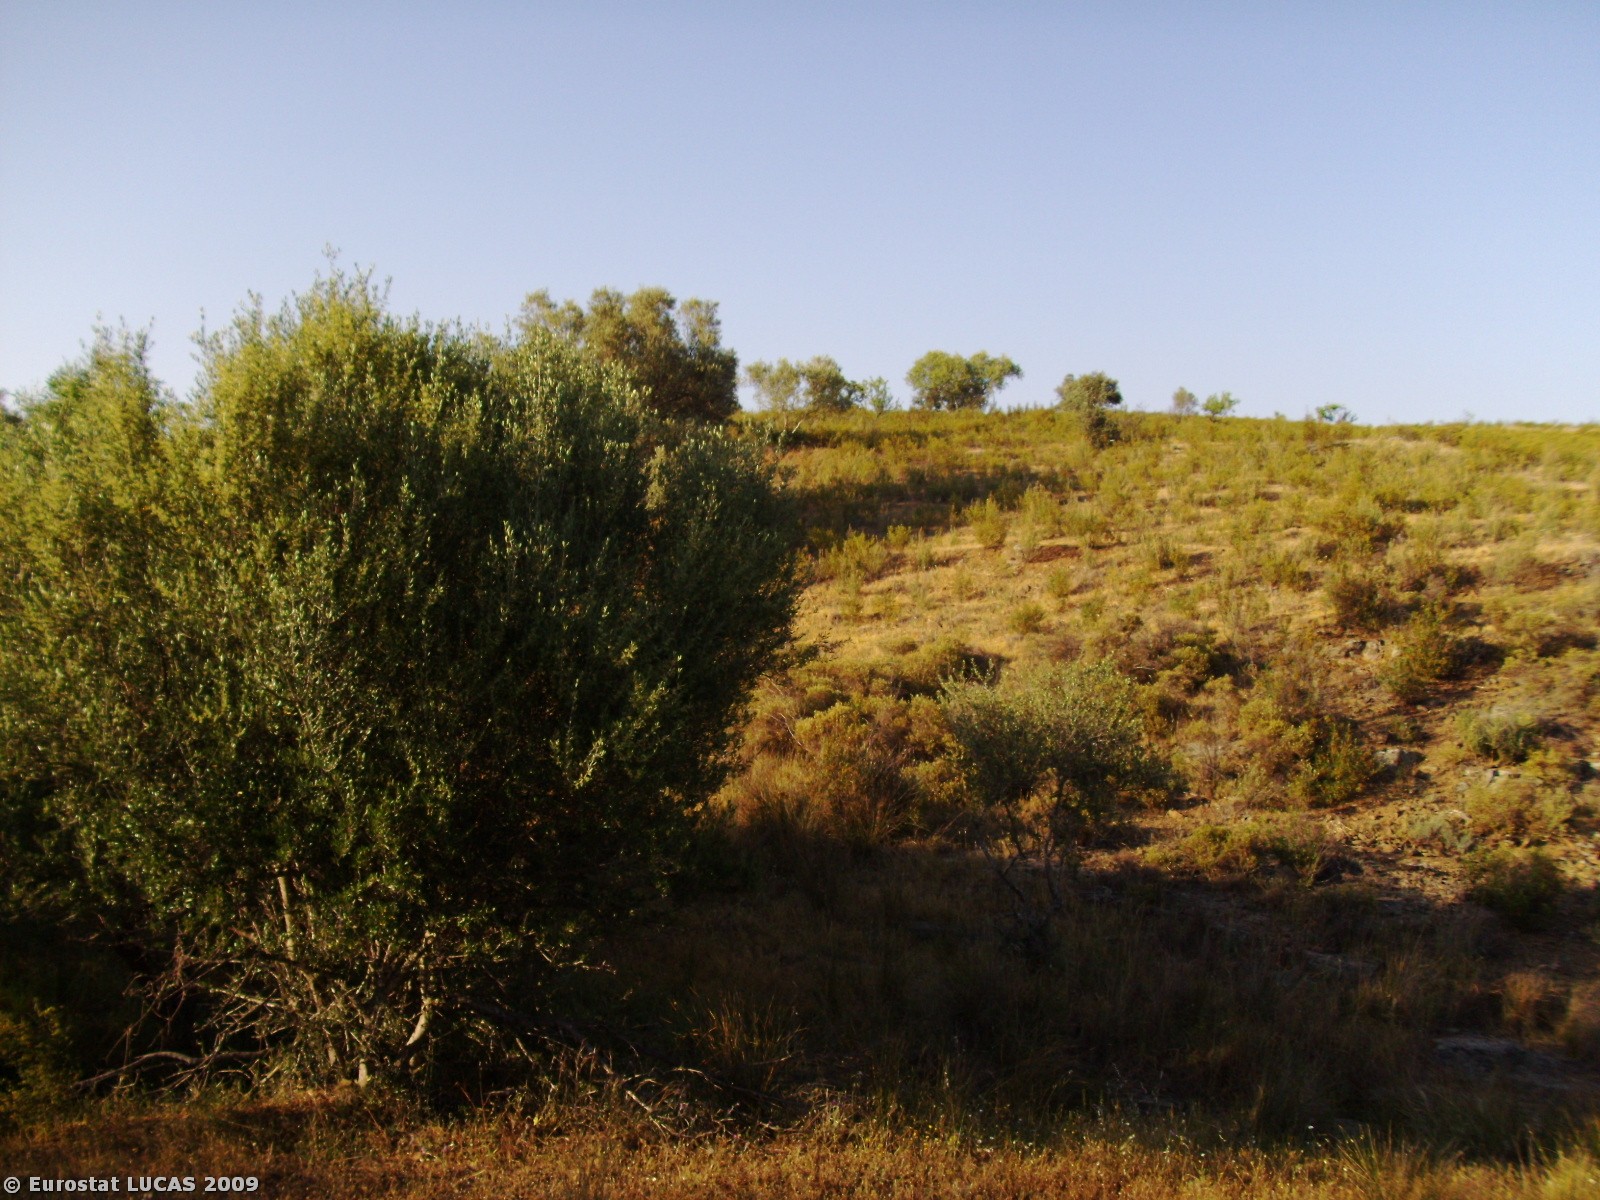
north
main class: Cropland
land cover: Olive groves
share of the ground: < 10 %
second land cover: Spontaneously vegetated surfaces
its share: > 75 %
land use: Agriculture (excluding fallow land and kitchen gardens)
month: May
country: PT
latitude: 37.2852
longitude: -7.4529
